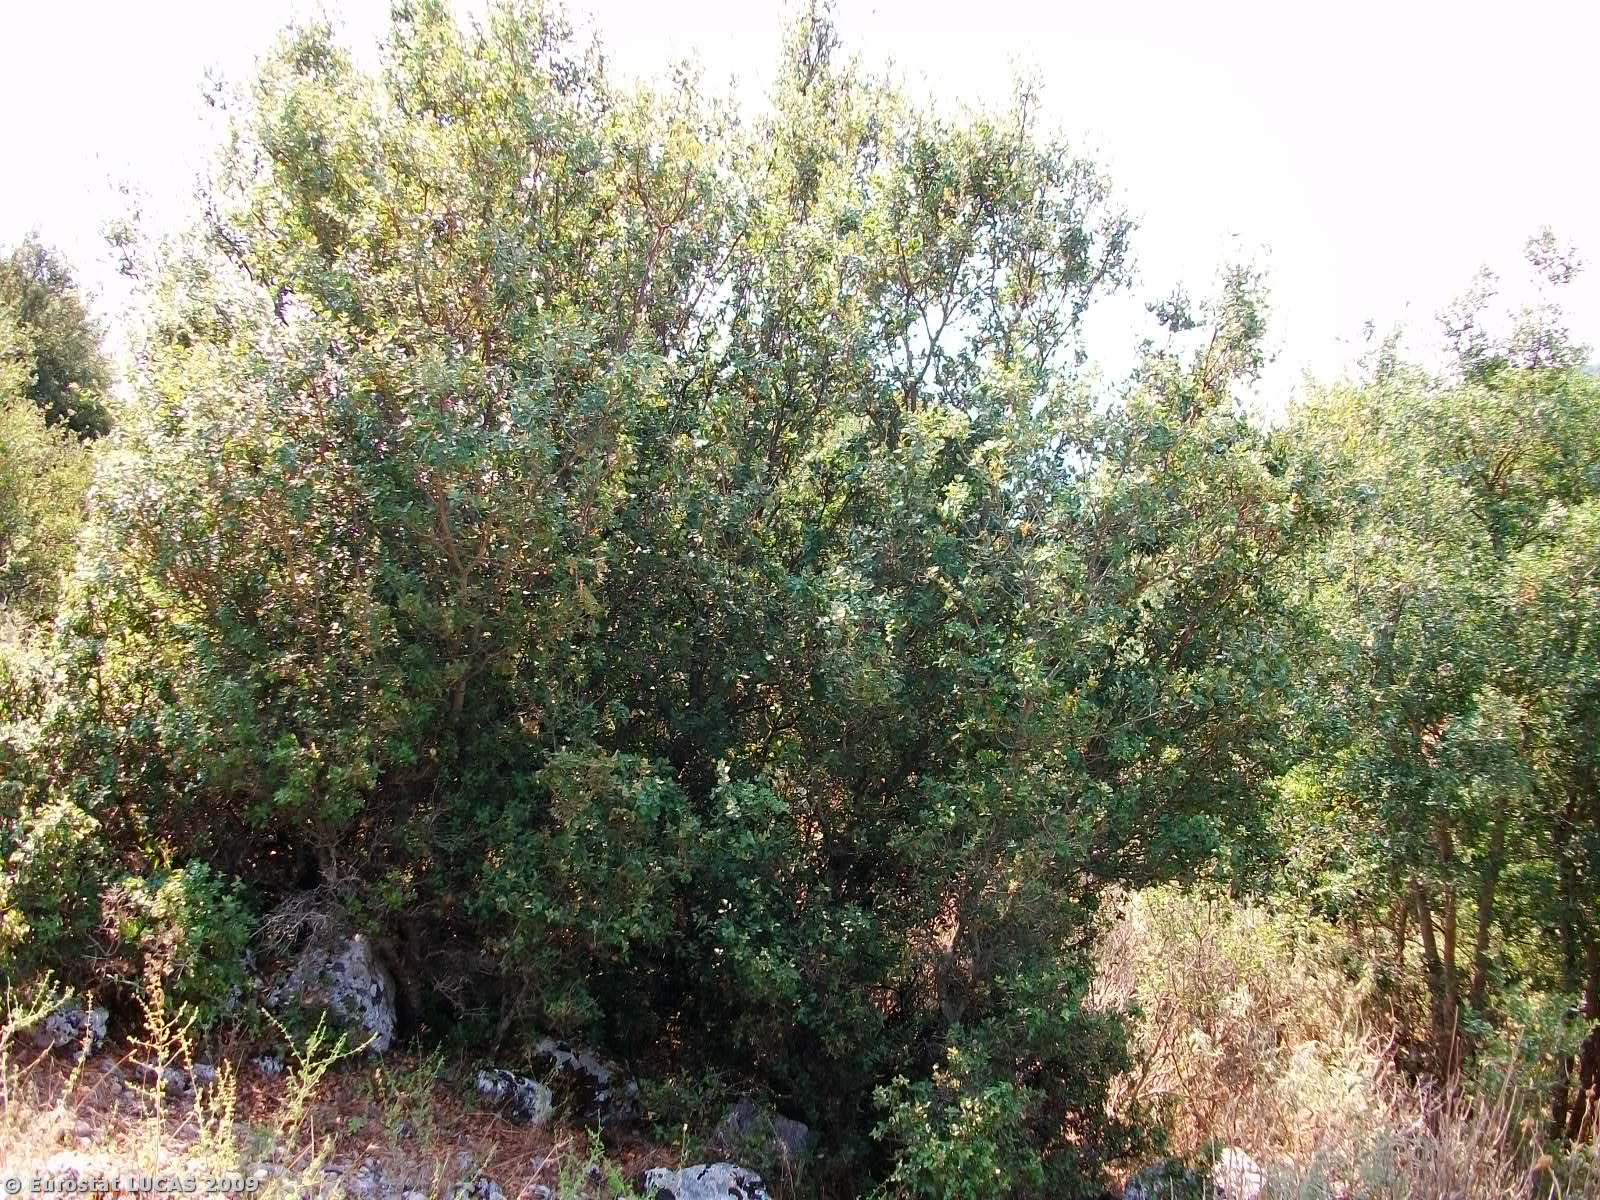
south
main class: Shrubland
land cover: Shrubland with sparse tree cover
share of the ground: > 75 %
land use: Agriculture (excluding fallow land and kitchen gardens)
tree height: < 5 m
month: August
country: GR
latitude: 39.3225
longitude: 20.4705
